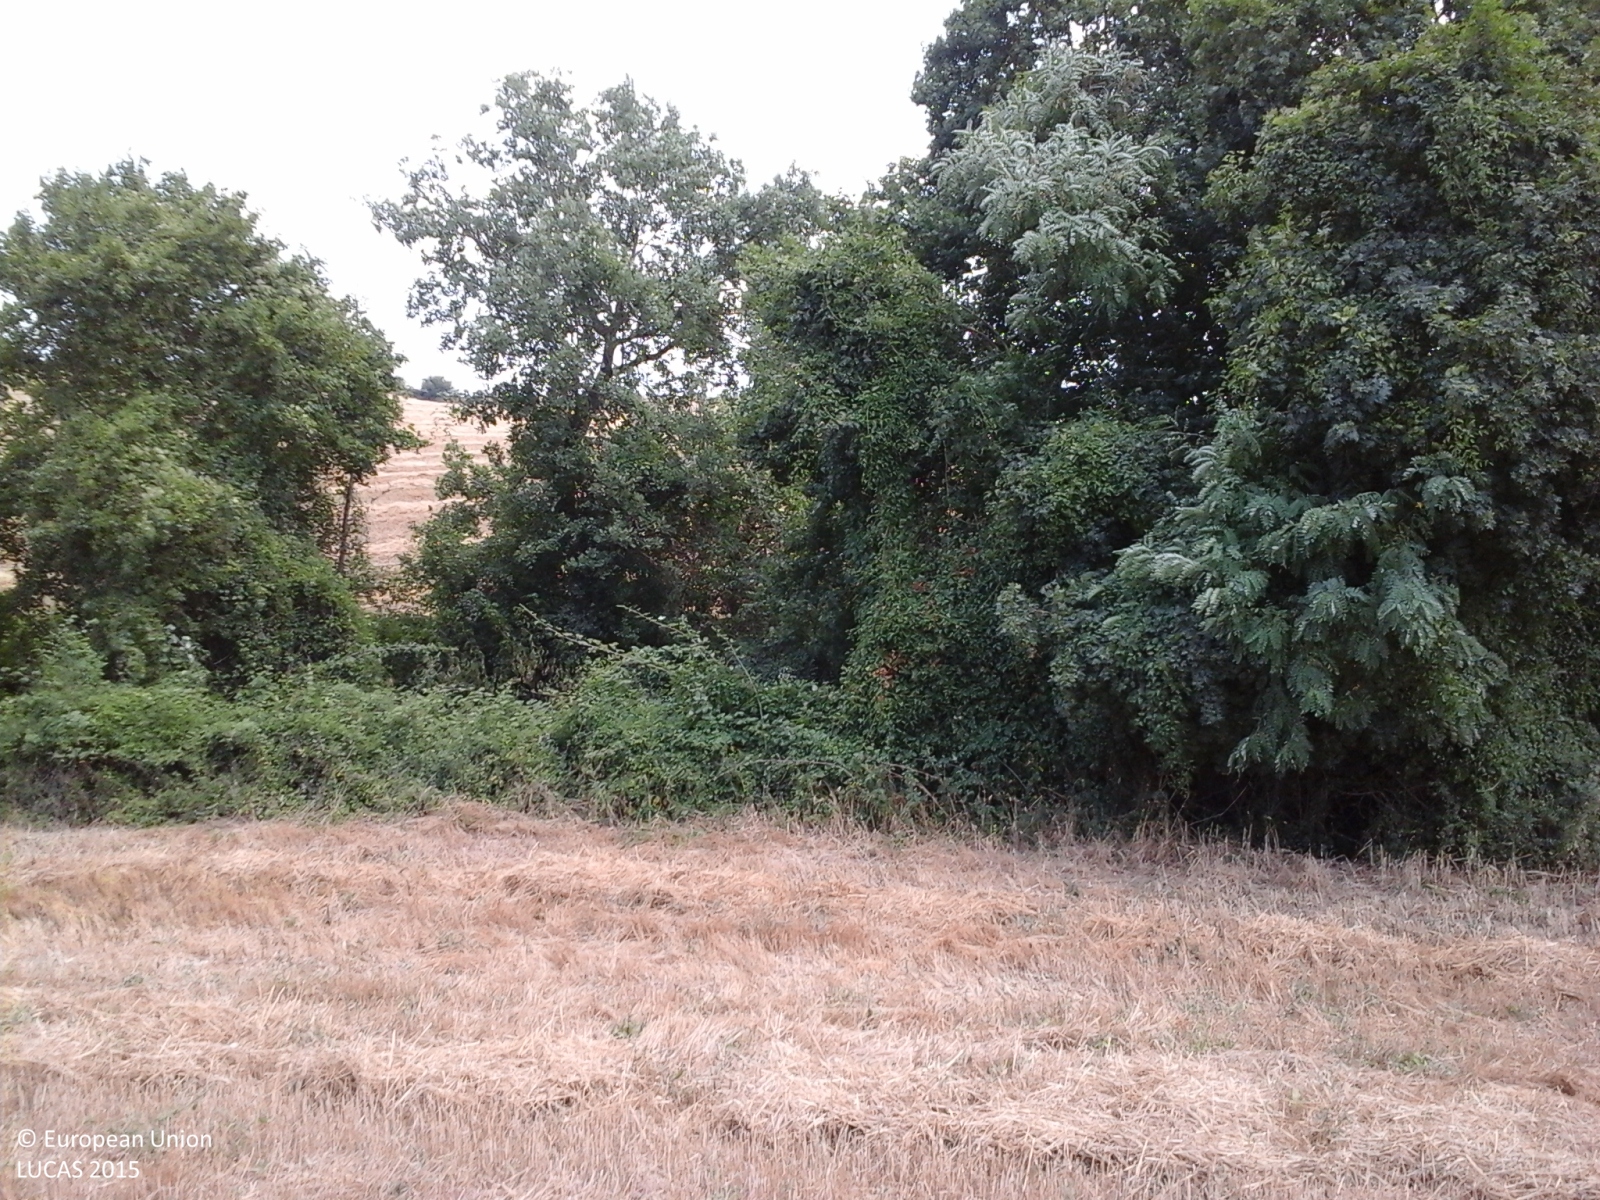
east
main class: Cropland
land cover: Durum wheat
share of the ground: > 75 %
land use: Agriculture (excluding fallow land and kitchen gardens)
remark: Harvested field
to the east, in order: Durum wheat; Broadleaved woodland; Ditches and canals; Broadleaved woodland; Durum wheat
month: July
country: IT
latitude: 43.0740
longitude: 11.6530
